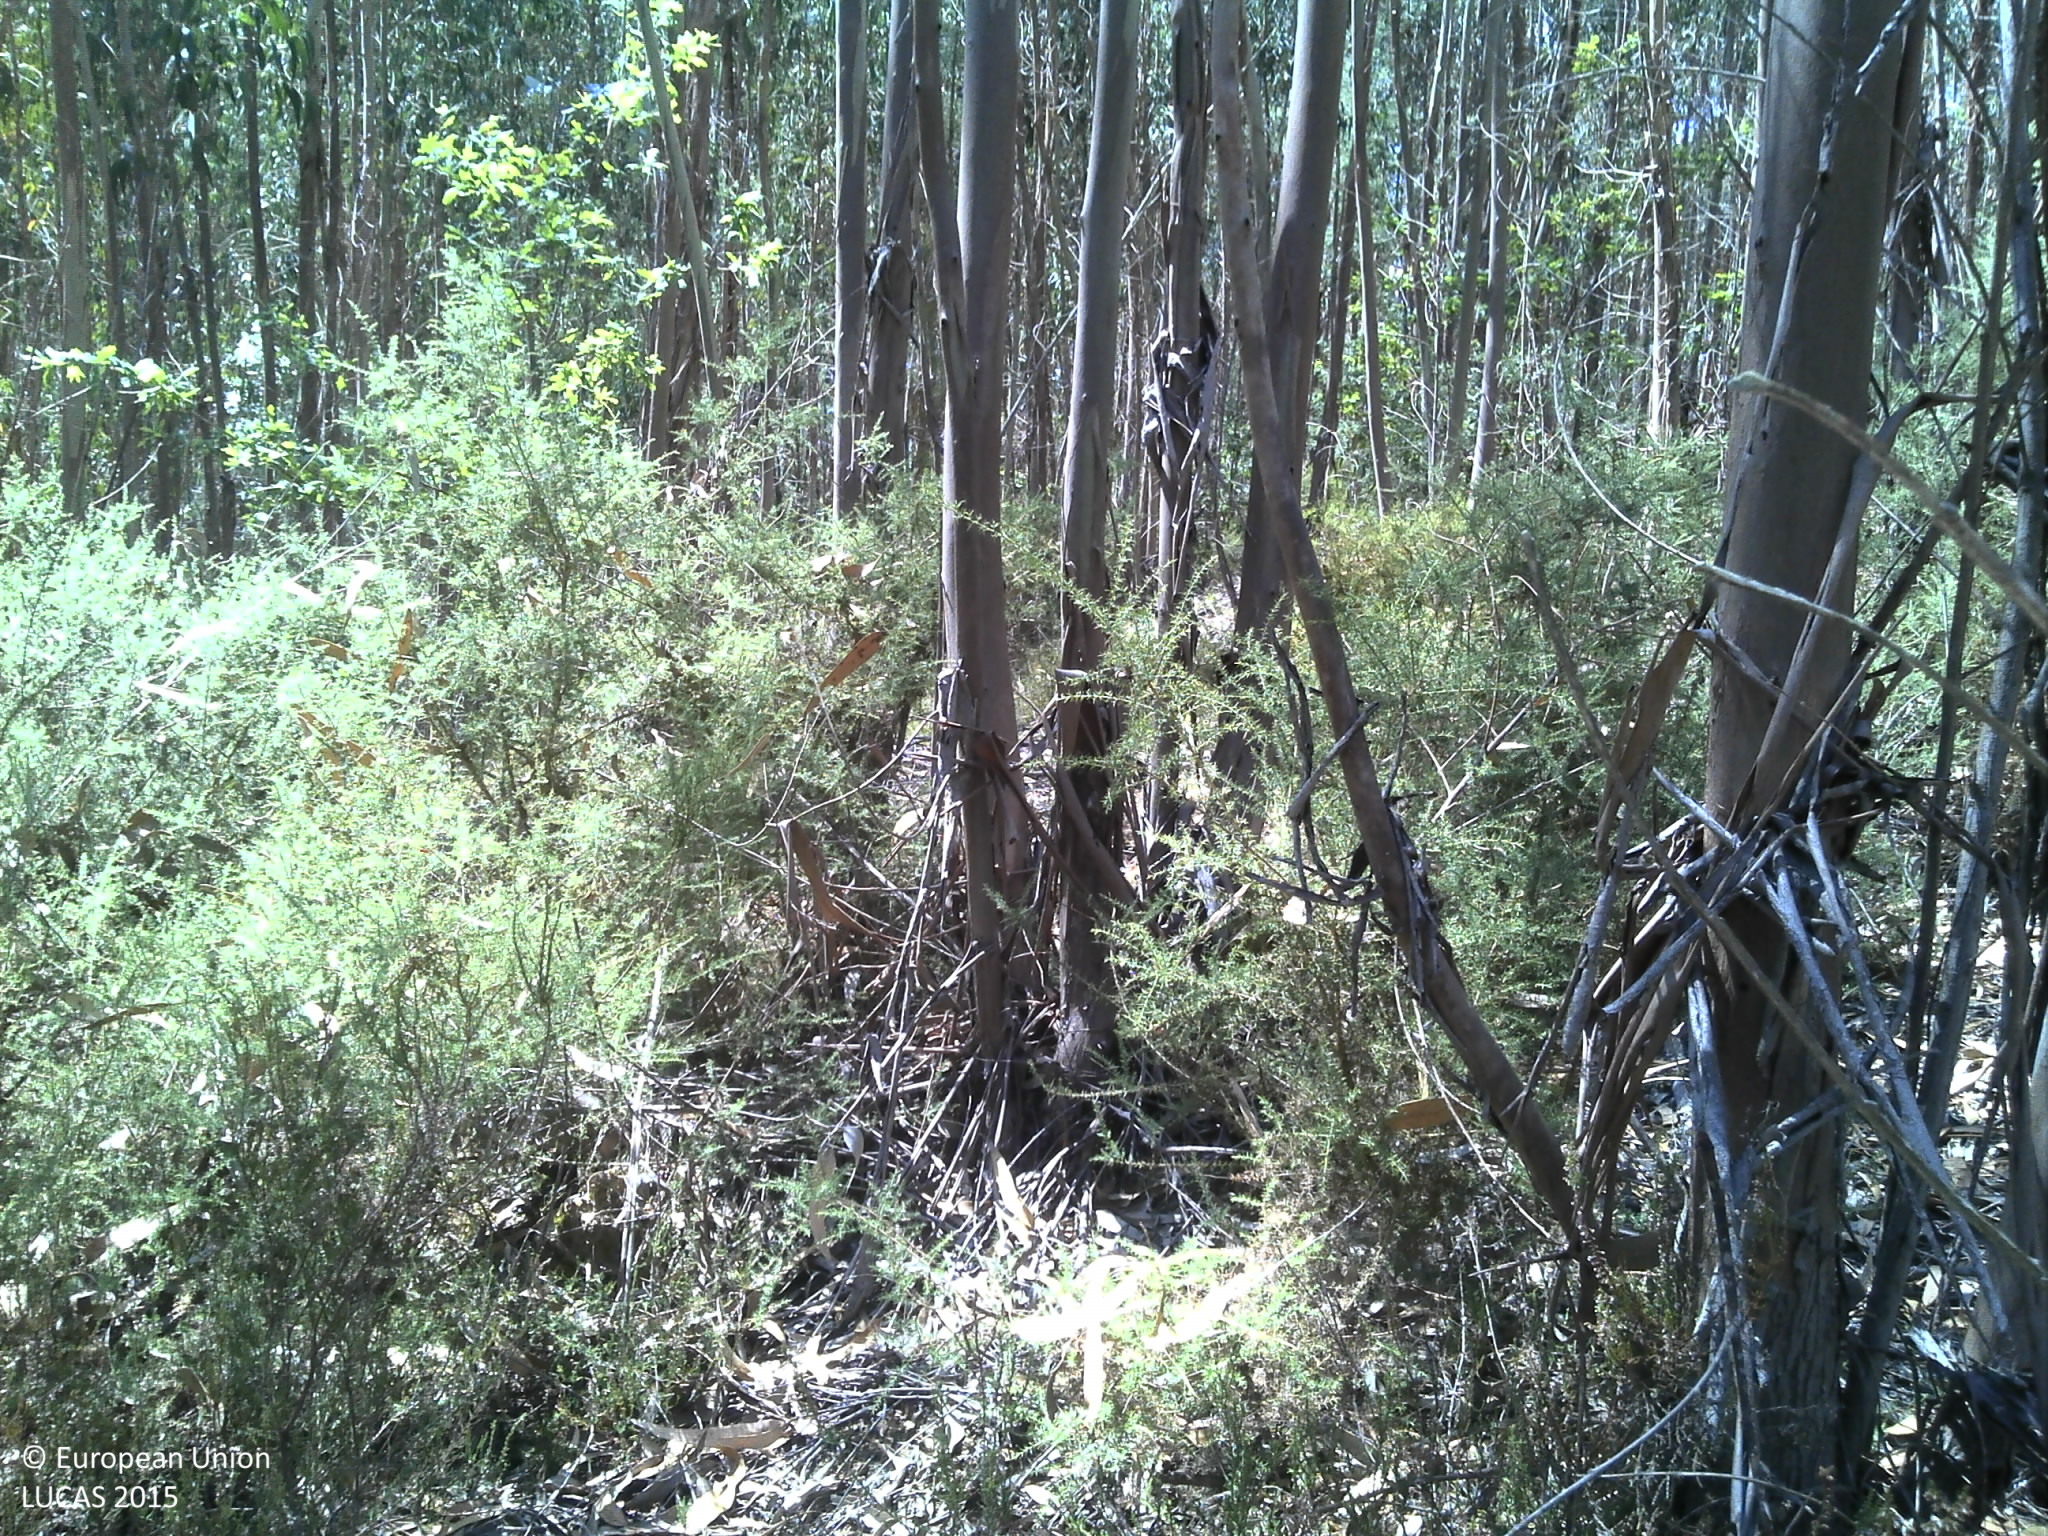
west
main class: Woodland
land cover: Broadleaved woodland
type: exotic forest
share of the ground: 50 - 75 %
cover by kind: broadleaved forest trees 60 %, unconsolidated bare surface 30 %, shrubs 10 %
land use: Forestry
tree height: > 5 m
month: July
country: PT
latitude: 40.3643
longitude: -8.1792
